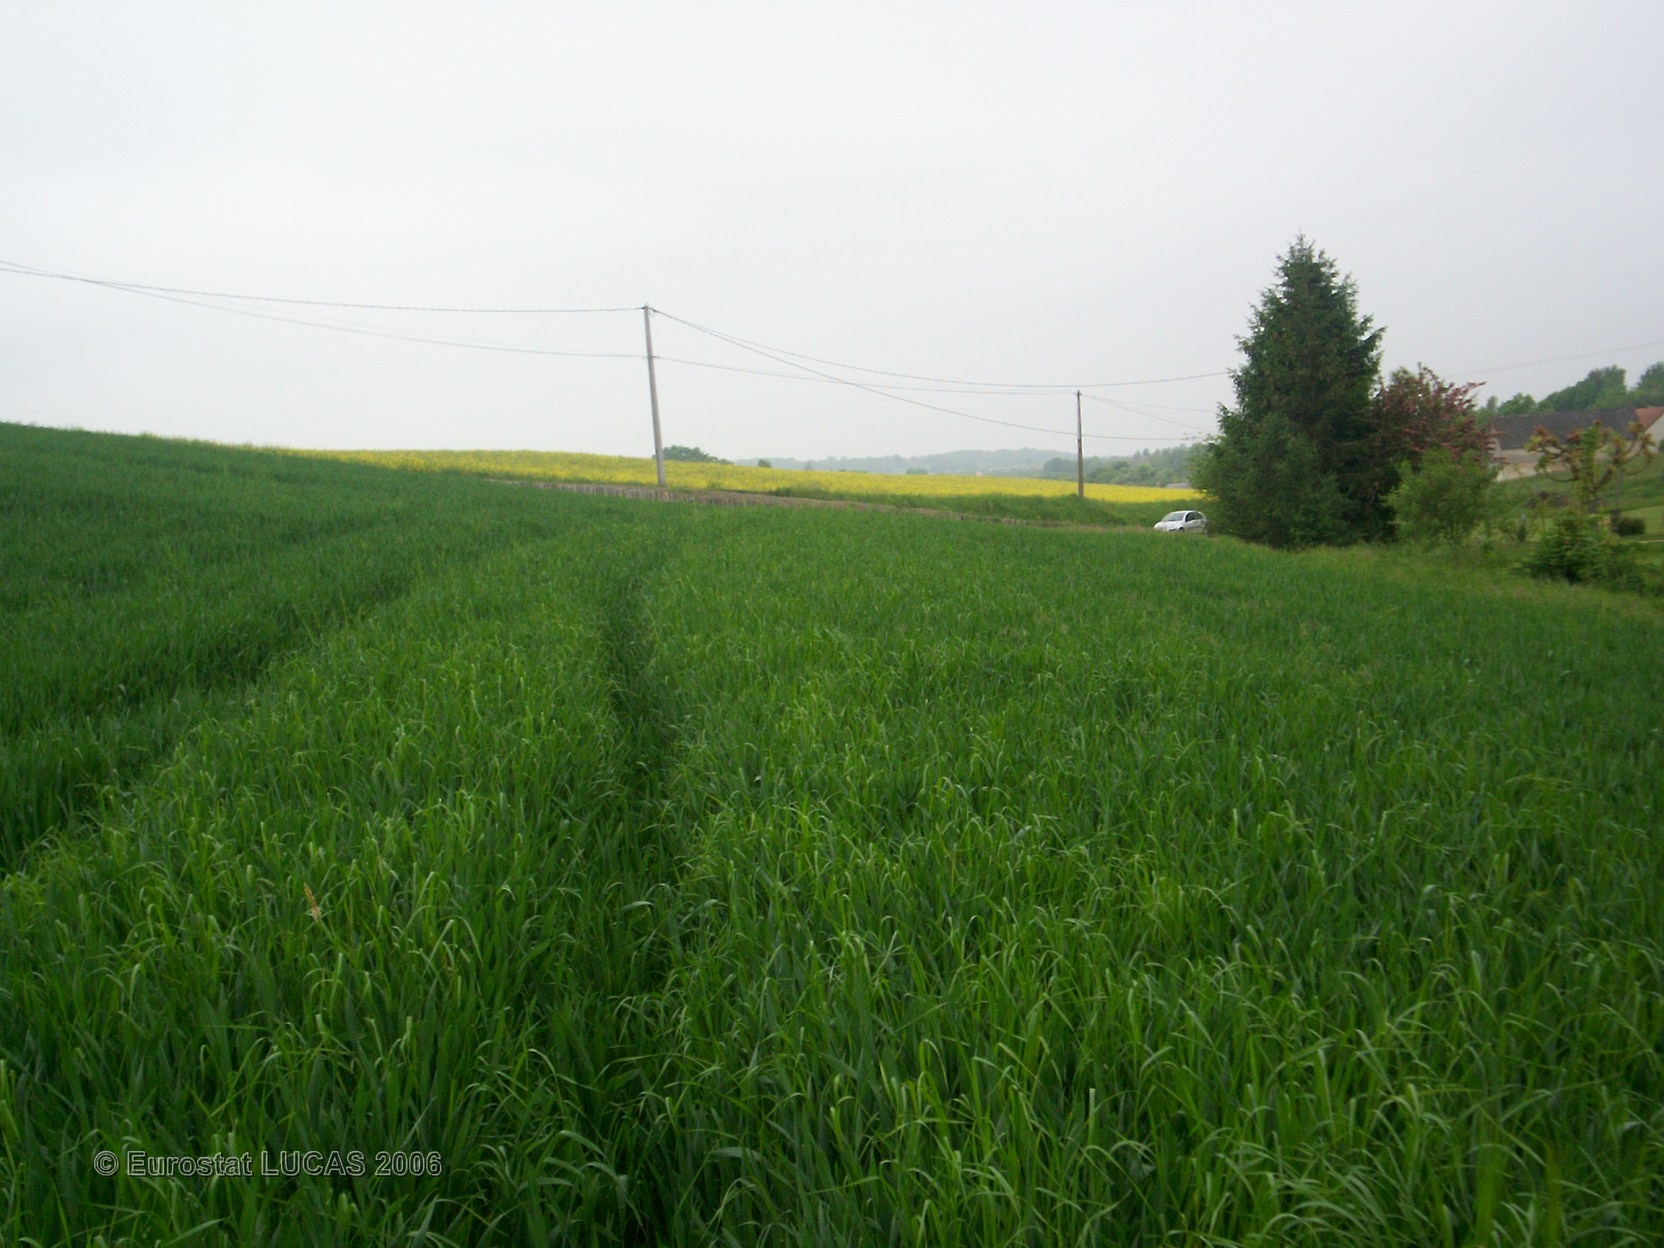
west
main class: Cropland
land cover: Common wheat
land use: Agriculture (excluding fallow land and kitchen gardens)
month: May
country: FR
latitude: 47.6482
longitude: 0.4860
